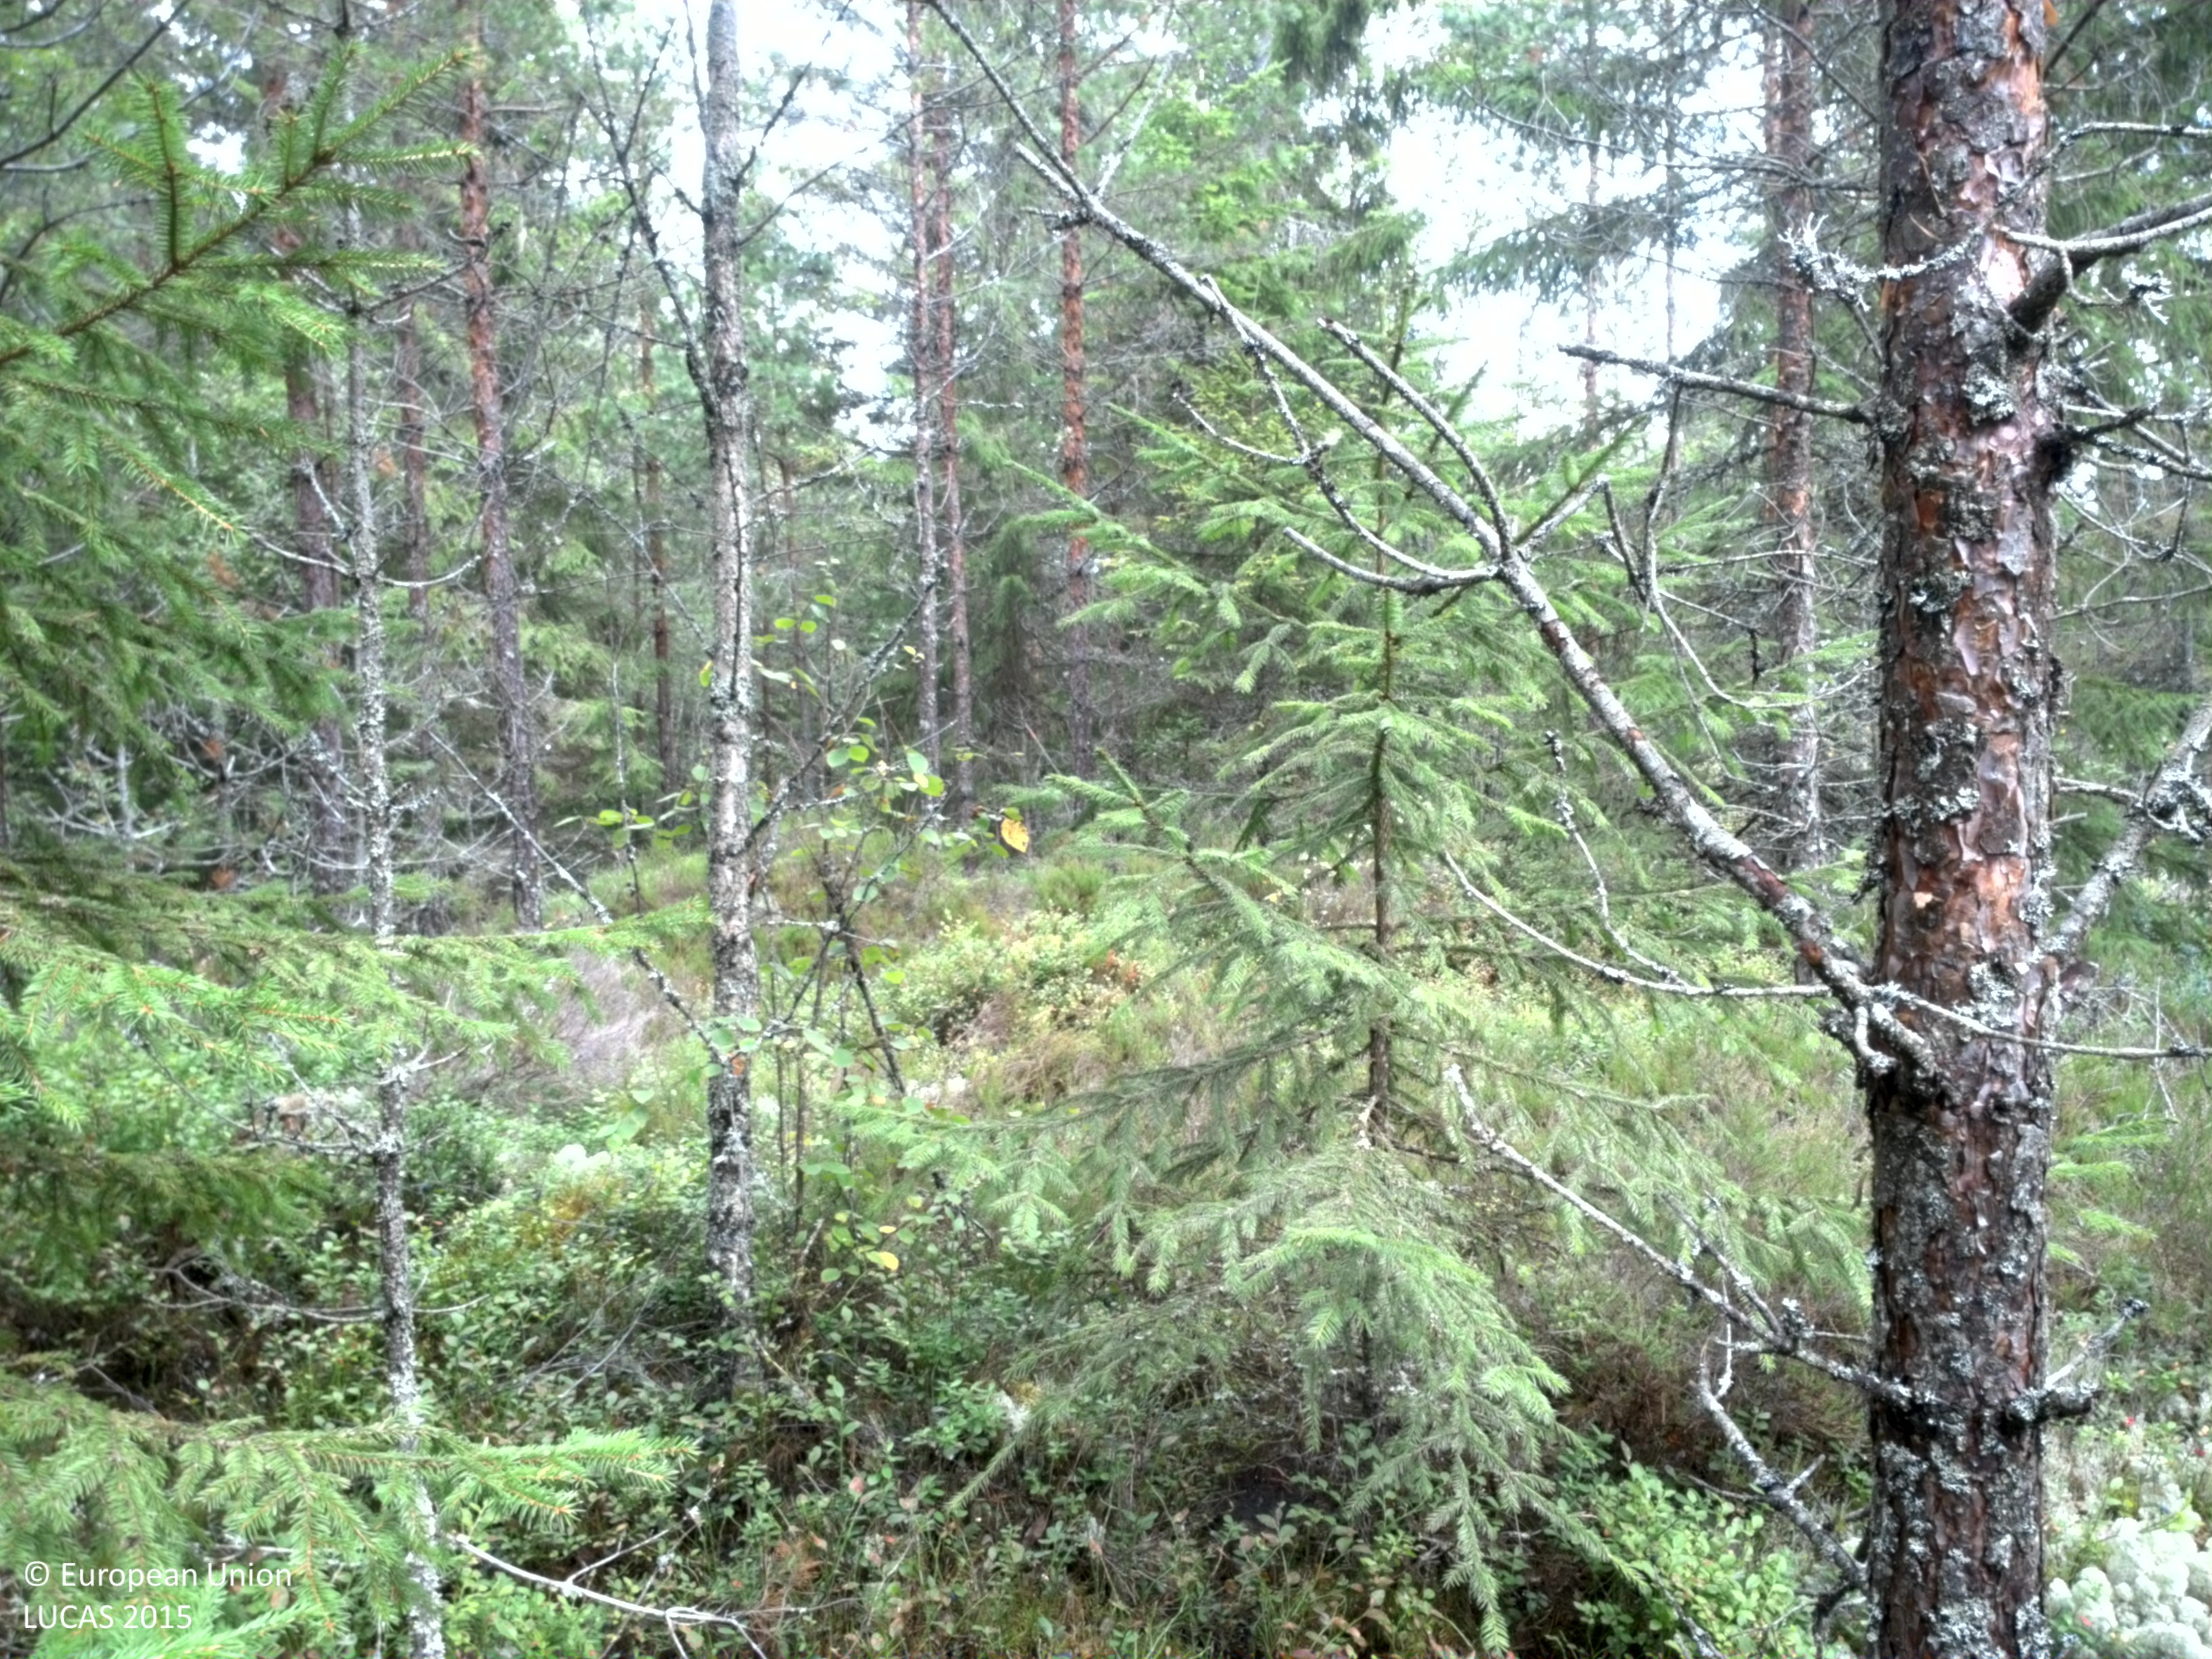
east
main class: Woodland
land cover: Pine dominated coniferous woodland
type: boreal forest
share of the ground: 25 - 50 %
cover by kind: coniferous forest trees 45 %, shrubs 30 %, lichens and mosses 20 %, broadleaved forest trees 5 %
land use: Forestry
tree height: > 5 m
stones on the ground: 25 - 50 %
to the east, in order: Pine dominated coniferous woodland; Spruce dominated coniferous woodland; Rivers and streams; Spruce dominated coniferous woodland
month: August
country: SE
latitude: 59.4242
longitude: 13.1826
